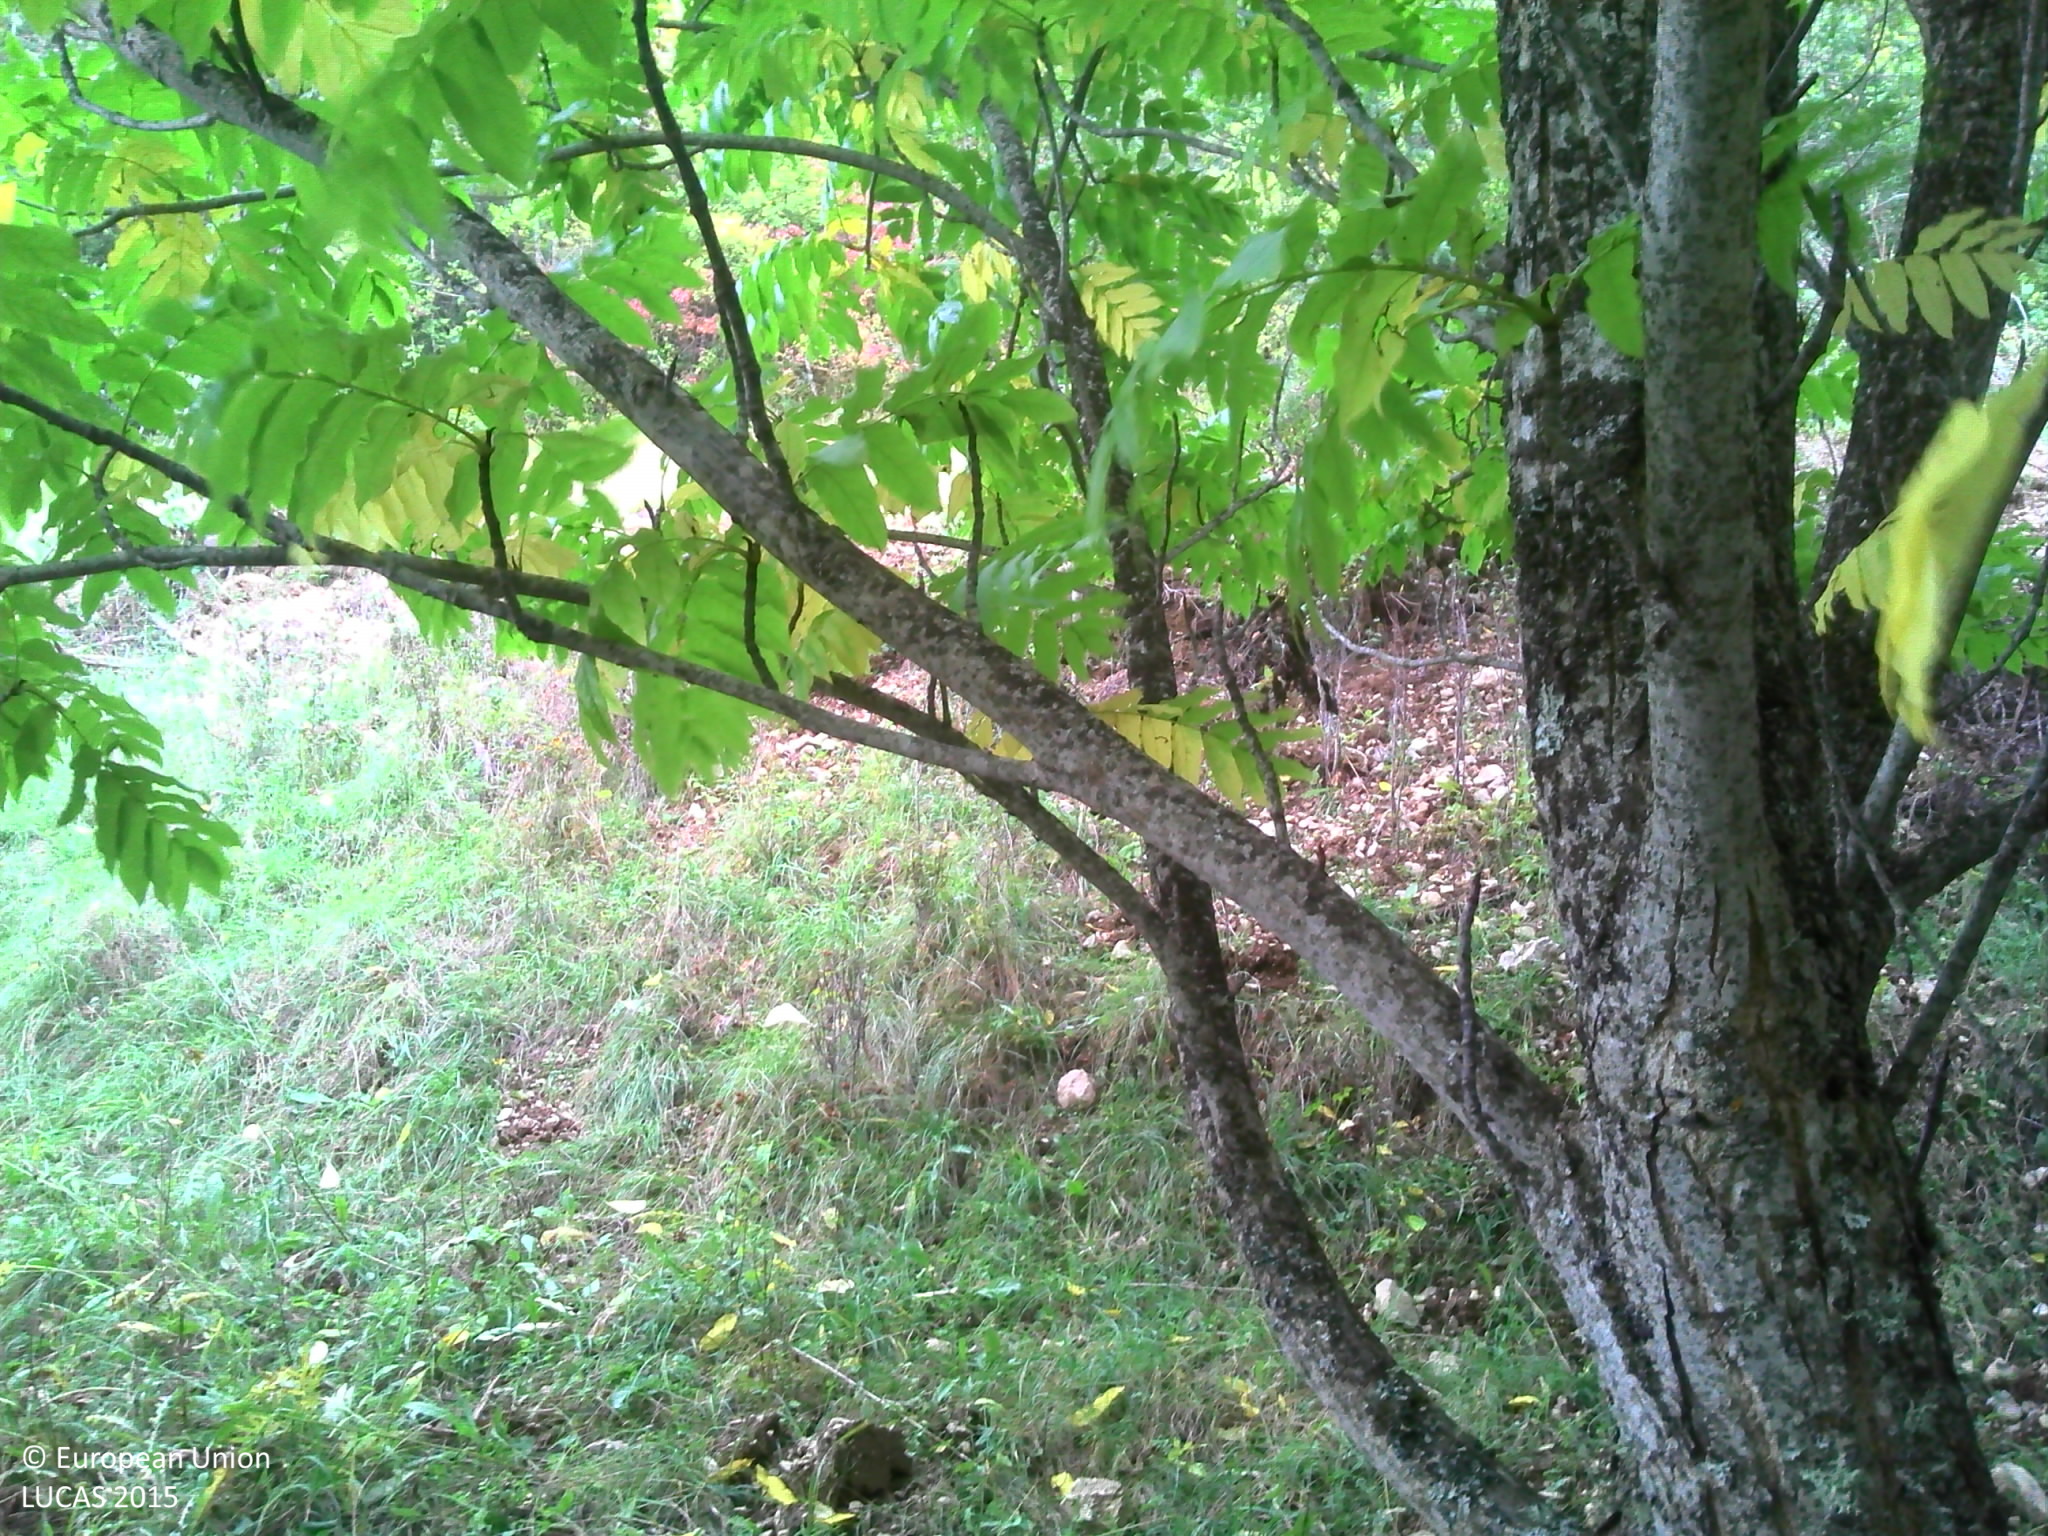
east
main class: Cropland
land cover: Nuts trees
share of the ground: 50 - 75 %
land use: Agriculture (excluding fallow land and kitchen gardens)
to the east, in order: Nuts trees; Tracks; Pine dominated mixed woodland; Pine dominated coniferous woodland; Shrubland with sparse tree cover; Tracks; Pine dominated coniferous woodland; Tracks; Pine dominated coniferous woodland; Pine dominated mixed woodland; Tracks; Pine dominated coniferous woodland; Grassland without tree/shrub cover
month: September
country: FR
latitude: 44.4346
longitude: 5.5222
